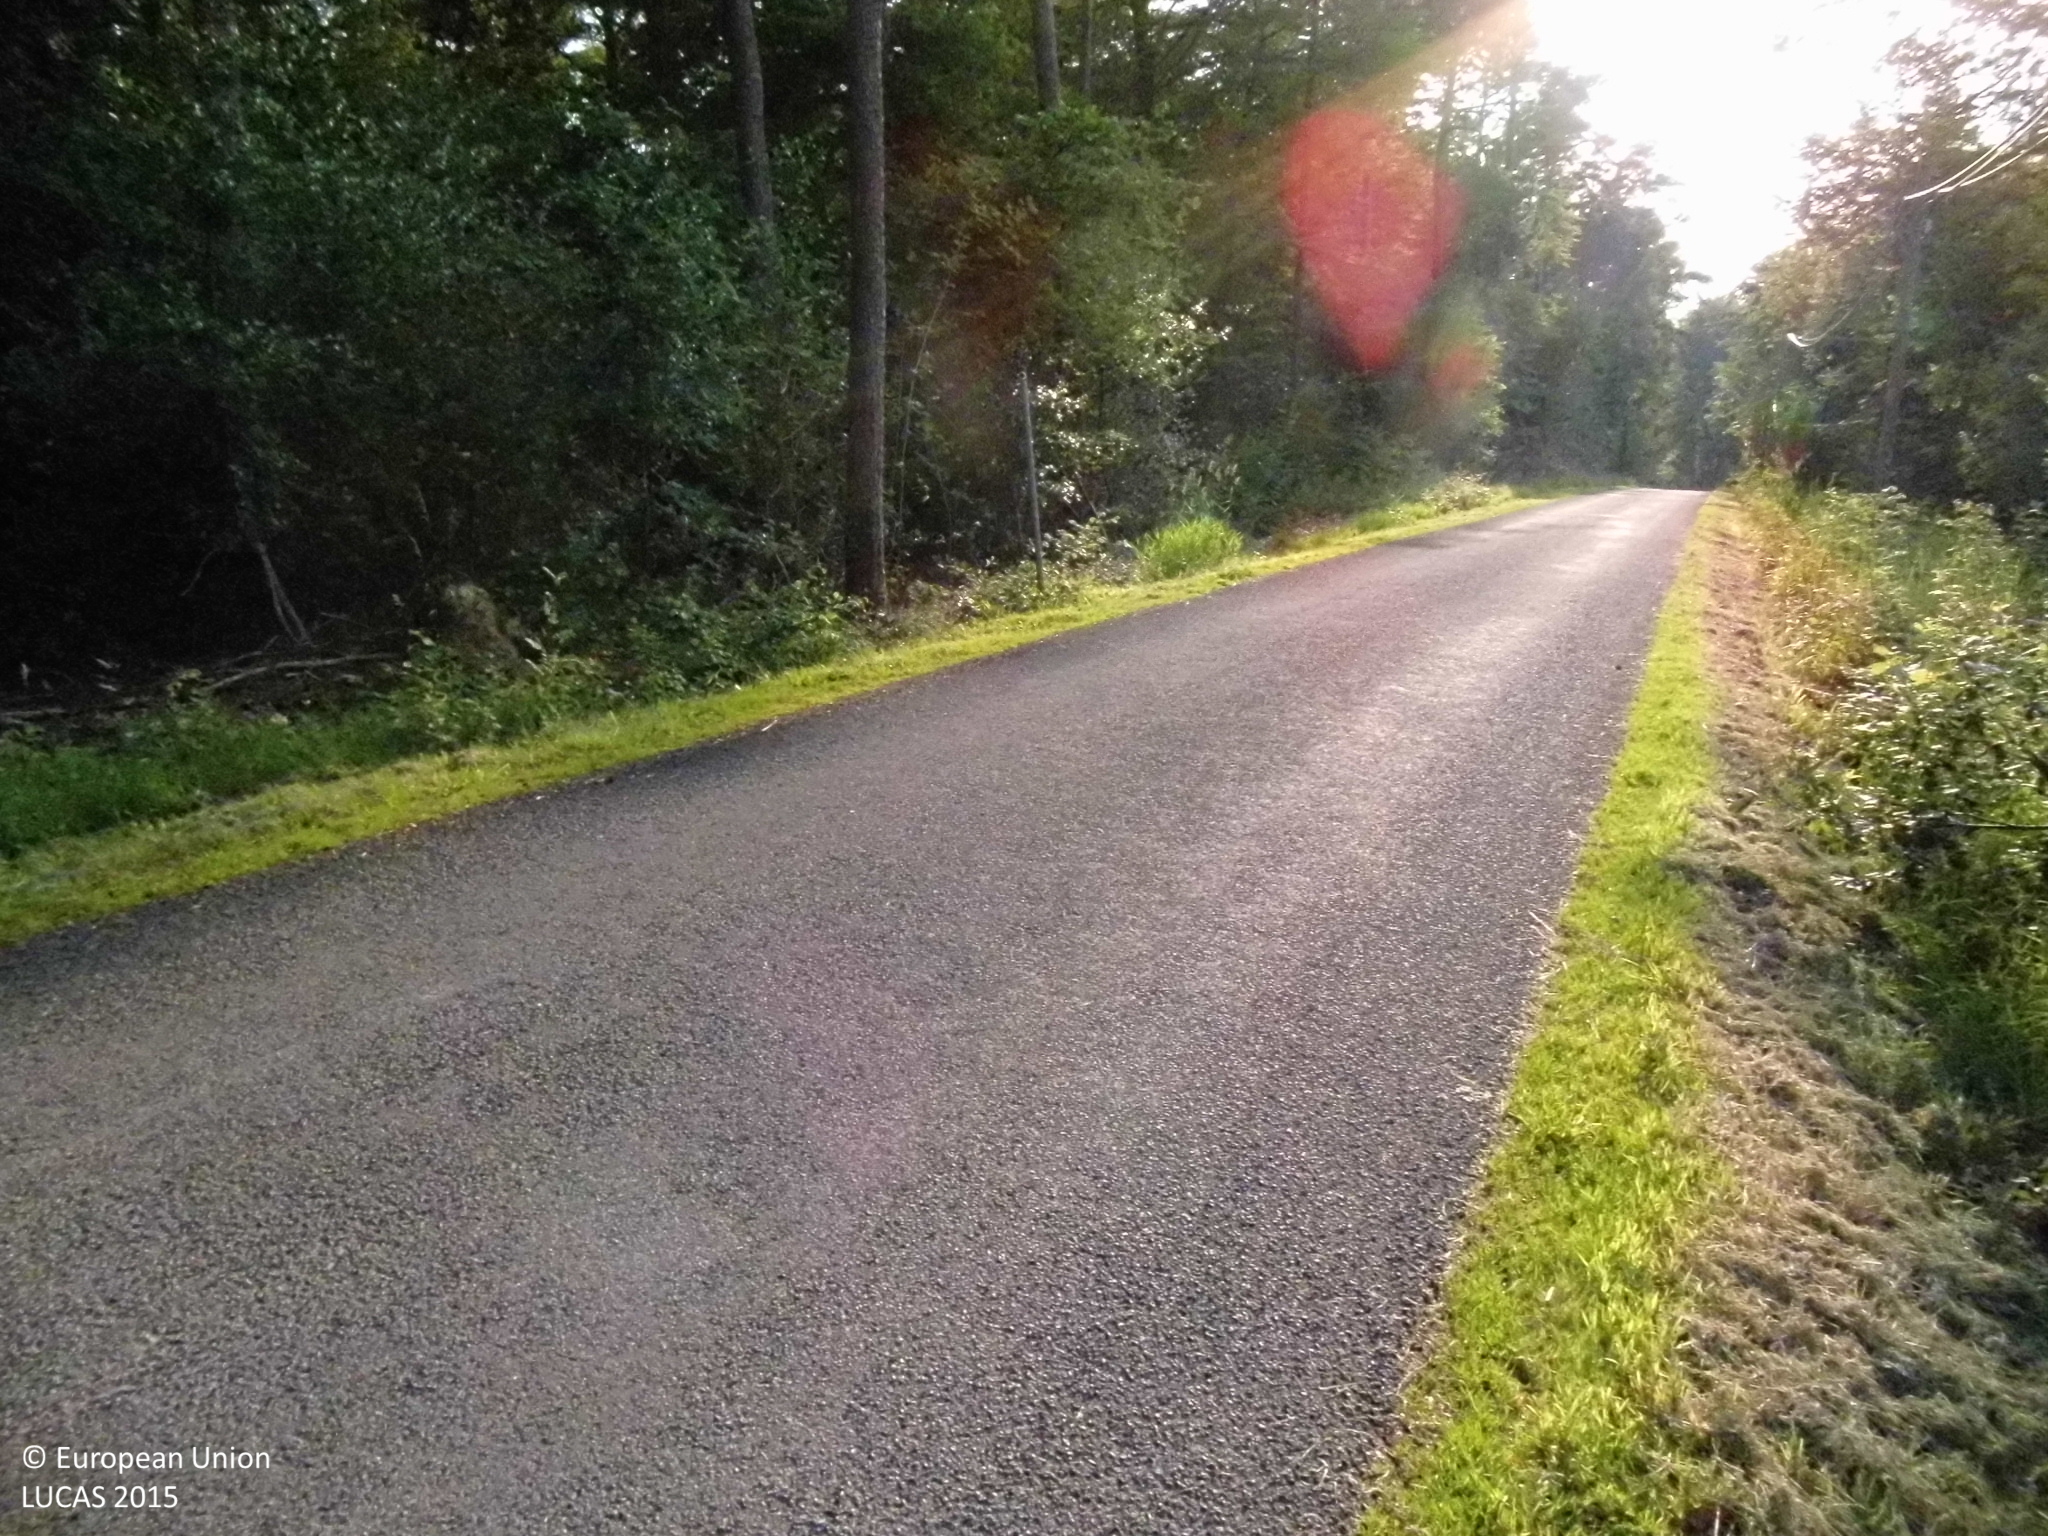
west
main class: Woodland
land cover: Broadleaved woodland
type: mesophytic deciduous forest
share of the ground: > 75 %
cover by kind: broadleaved forest trees 100 %
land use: Forestry
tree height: > 5 m
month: June
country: DE
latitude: 50.8222
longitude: 7.4876
